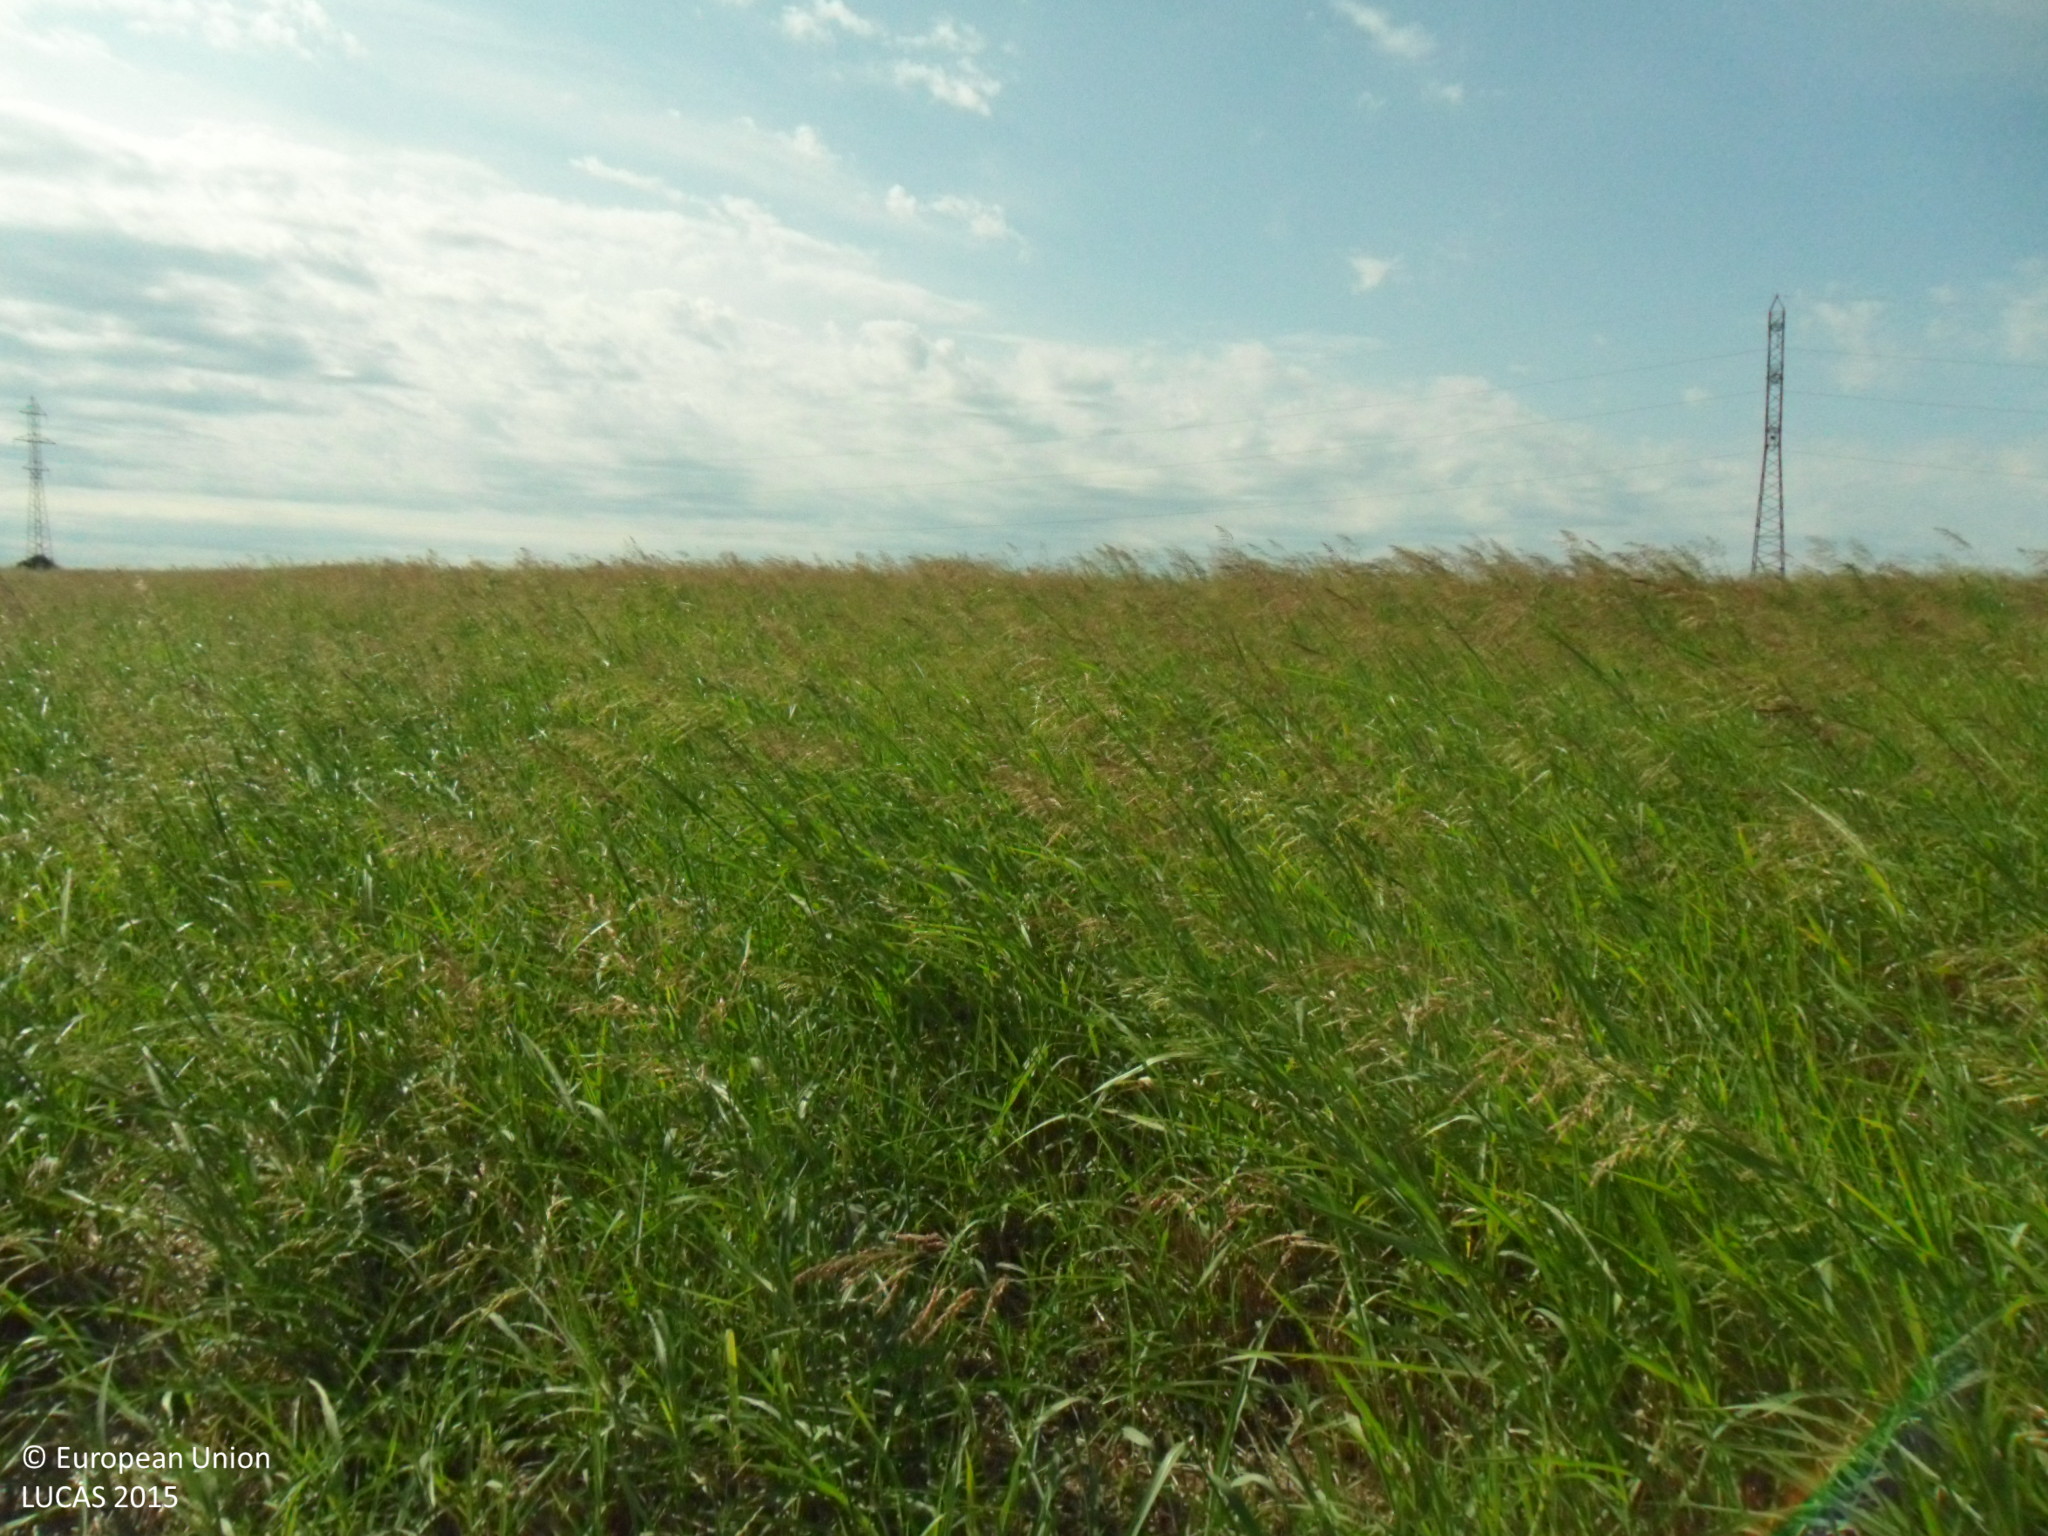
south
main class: Cropland
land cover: Common wheat
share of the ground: < 10 %
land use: Agriculture (excluding fallow land and kitchen gardens)
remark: Harvested field
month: September
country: BG
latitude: 43.5899
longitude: 26.2635
